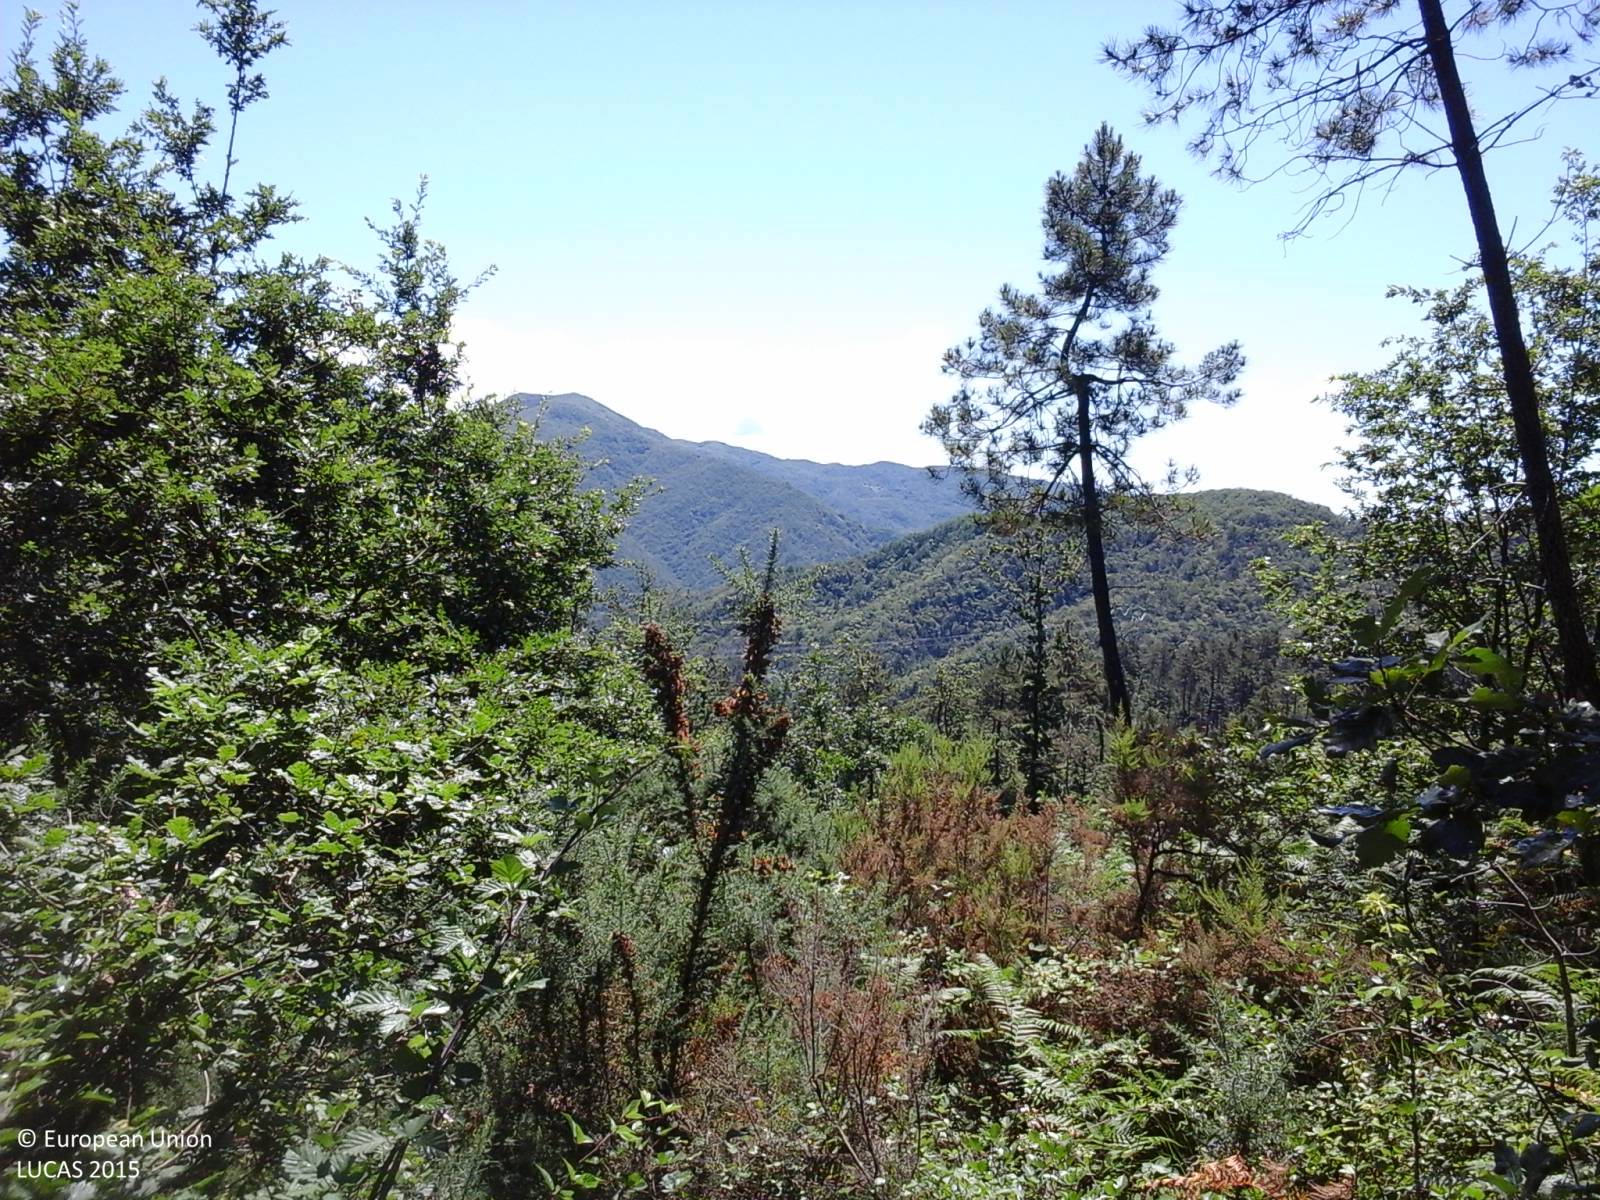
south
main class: Woodland
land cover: Broadleaved woodland
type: thermophilous deciduous forest
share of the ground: > 75 %
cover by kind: broadleaved forest trees 80 %, coniferous forest trees 10 %, shrubs 10 %
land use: Semi-natural and natural areas not in use
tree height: > 5 m
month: June
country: IT
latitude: 44.2062
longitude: 9.9126
